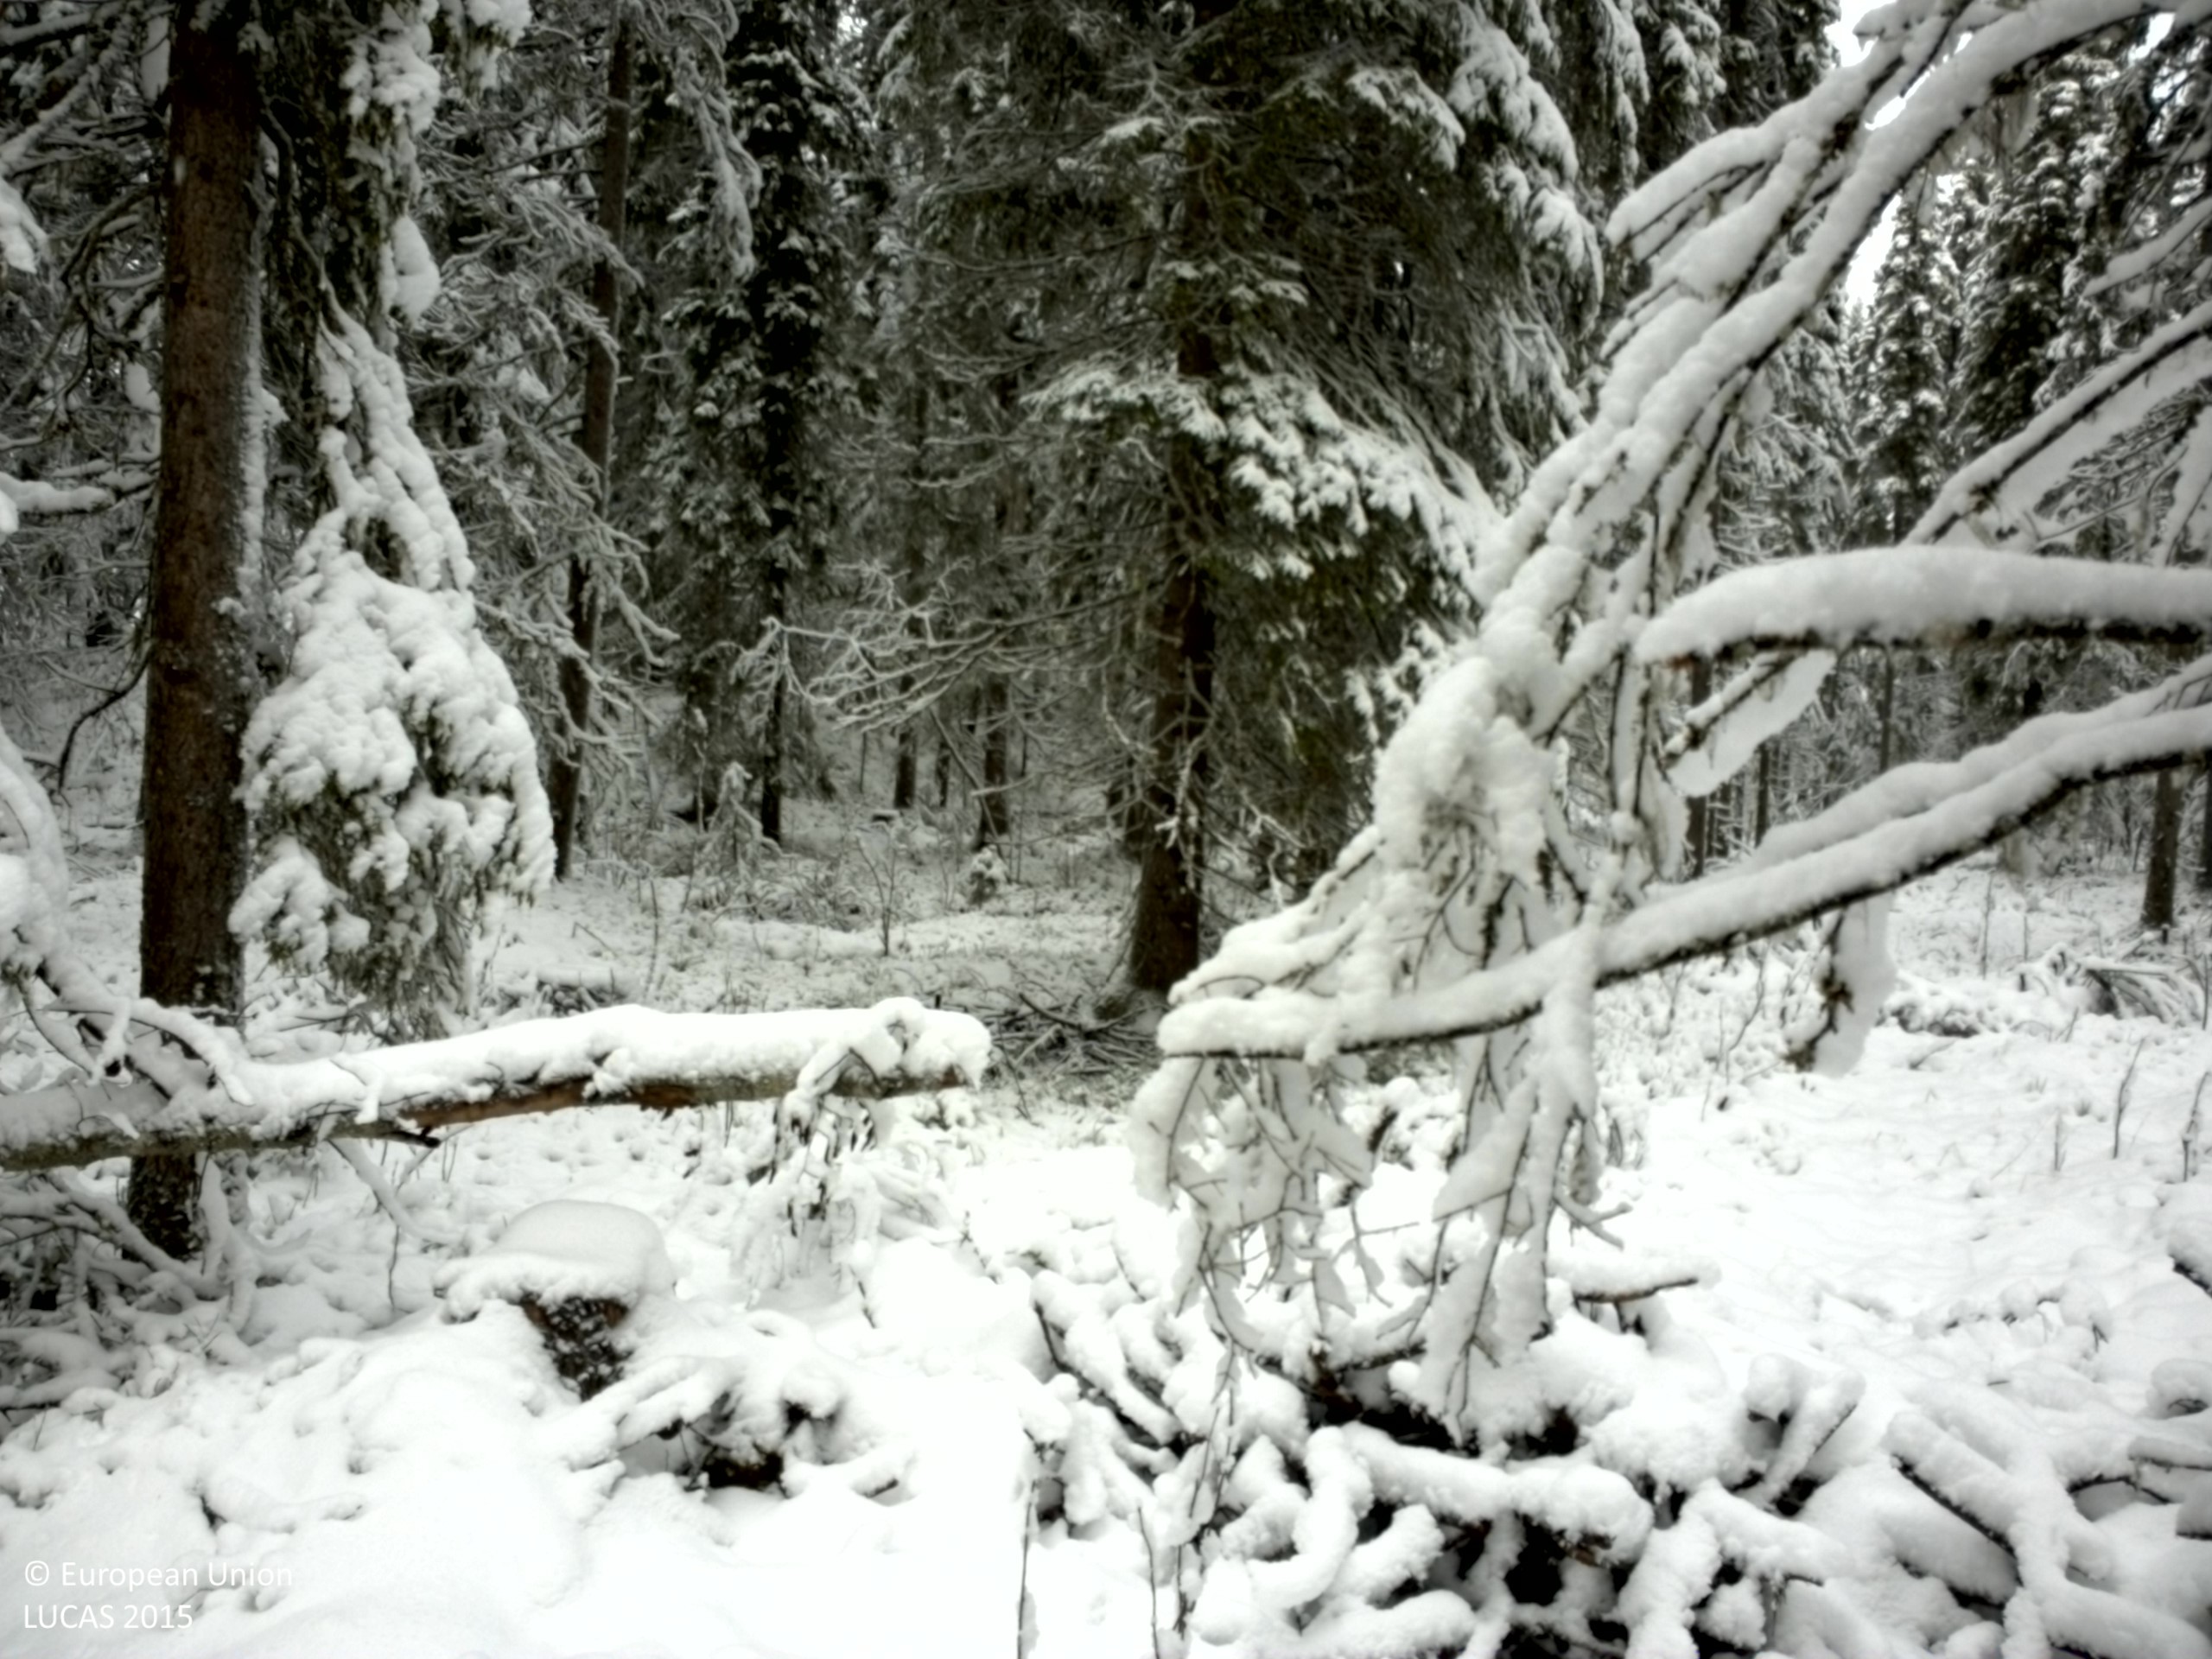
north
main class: Woodland
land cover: Spruce dominated coniferous woodland
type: boreal forest
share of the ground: > 75 %
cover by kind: coniferous forest trees 70 %, shrubs 15 %, lichens and mosses 10 %, broadleaved forest trees 5 %
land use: Forestry
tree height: > 5 m
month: November
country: SE
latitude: 63.7430
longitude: 15.4645
